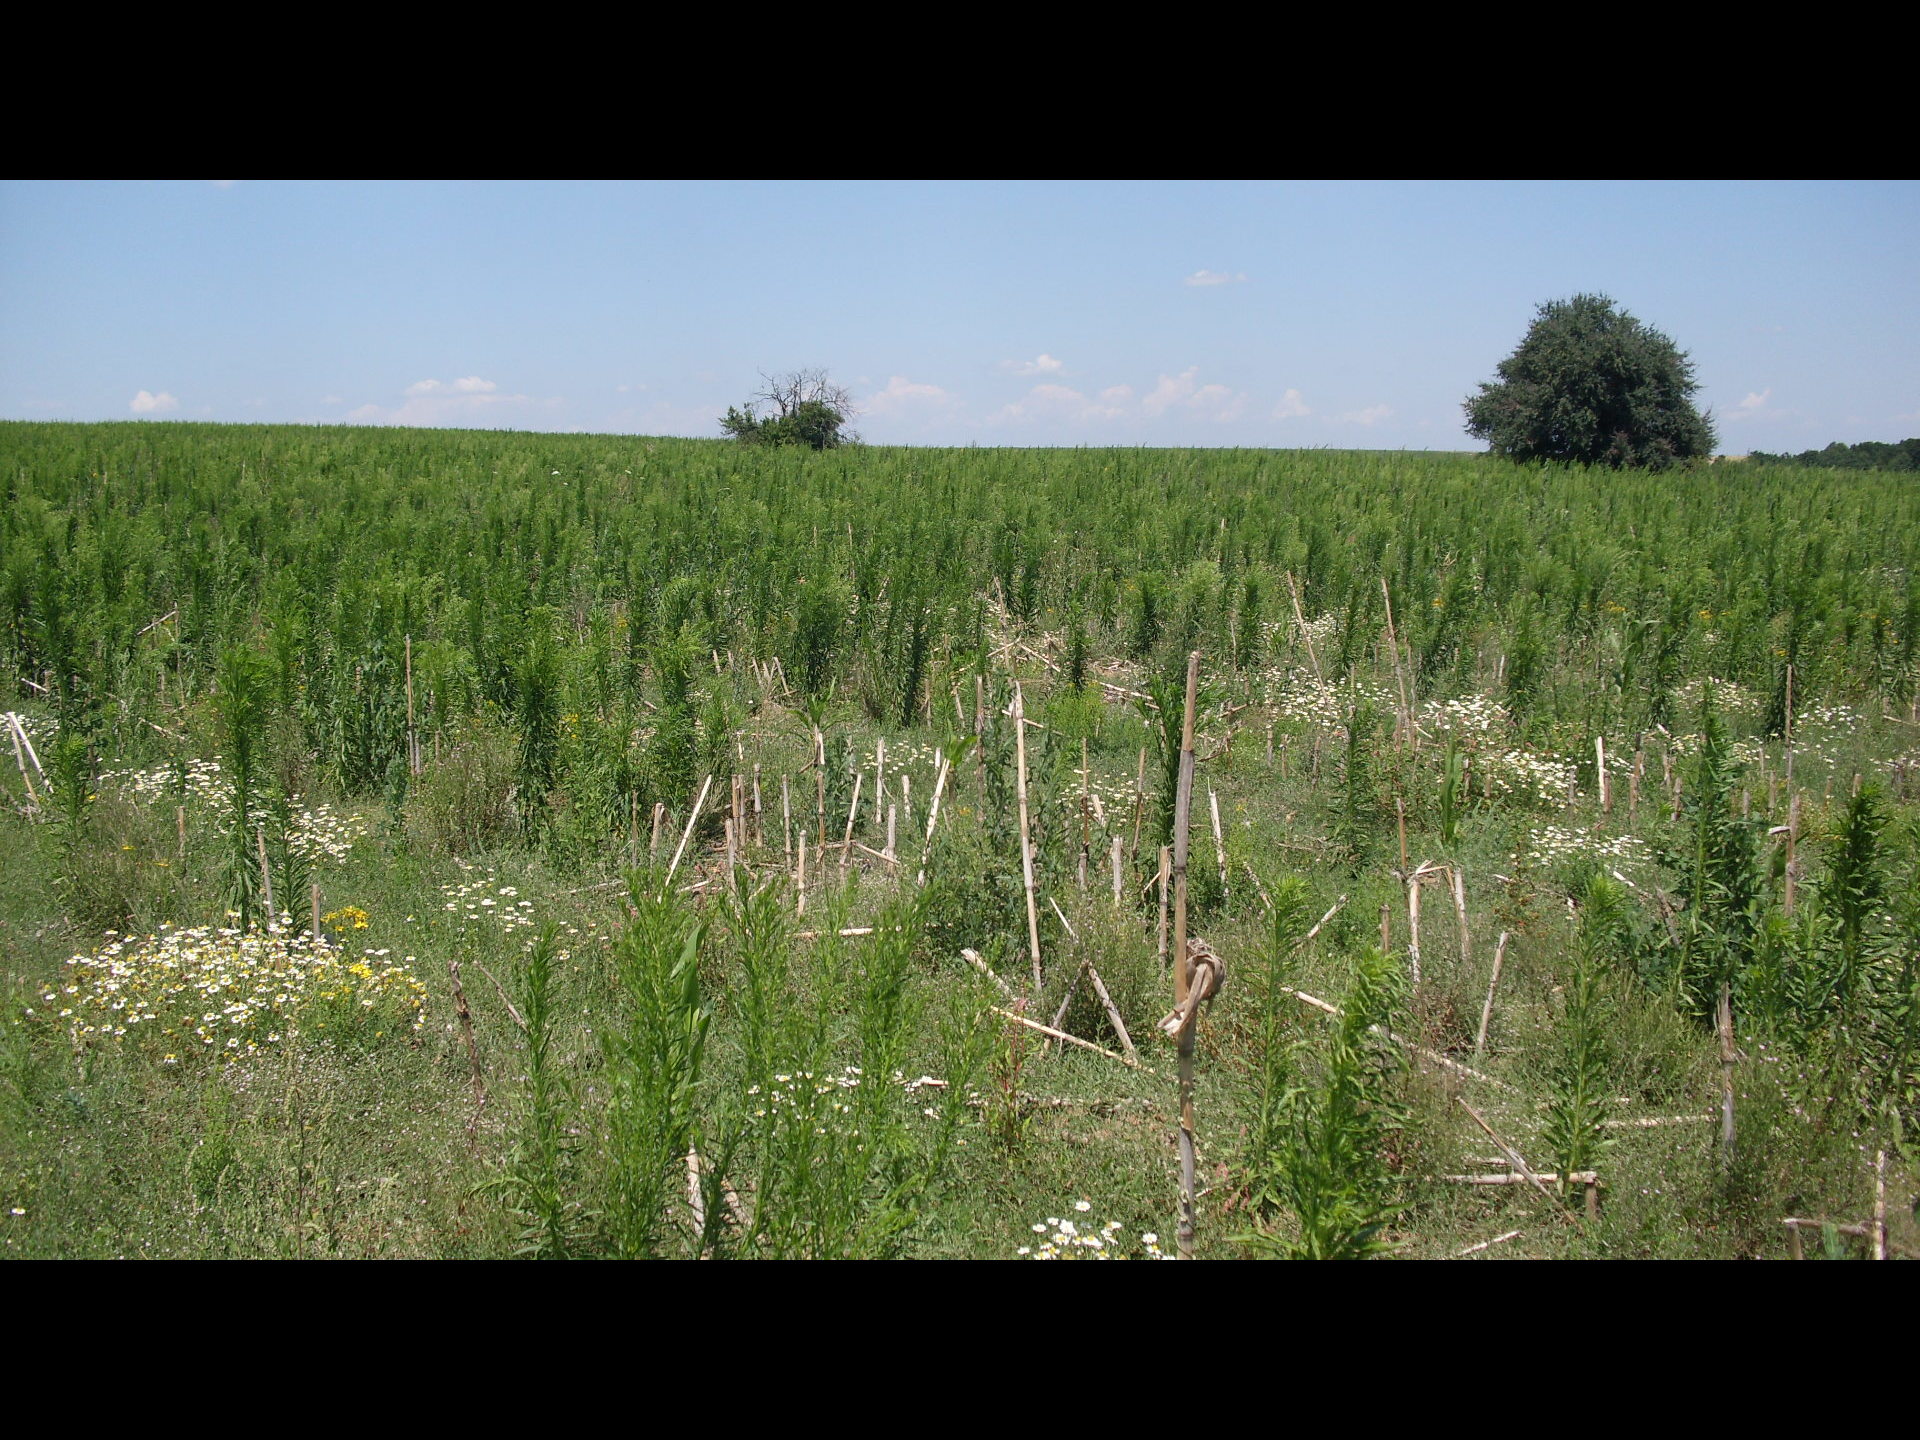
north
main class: Grassland
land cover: Spontaneously vegetated surfaces
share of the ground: > 75 %
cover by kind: herbaceous plants 95 %, shrubs 5 %
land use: Fallow land
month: July
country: BG
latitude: 43.5945
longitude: 23.0574
